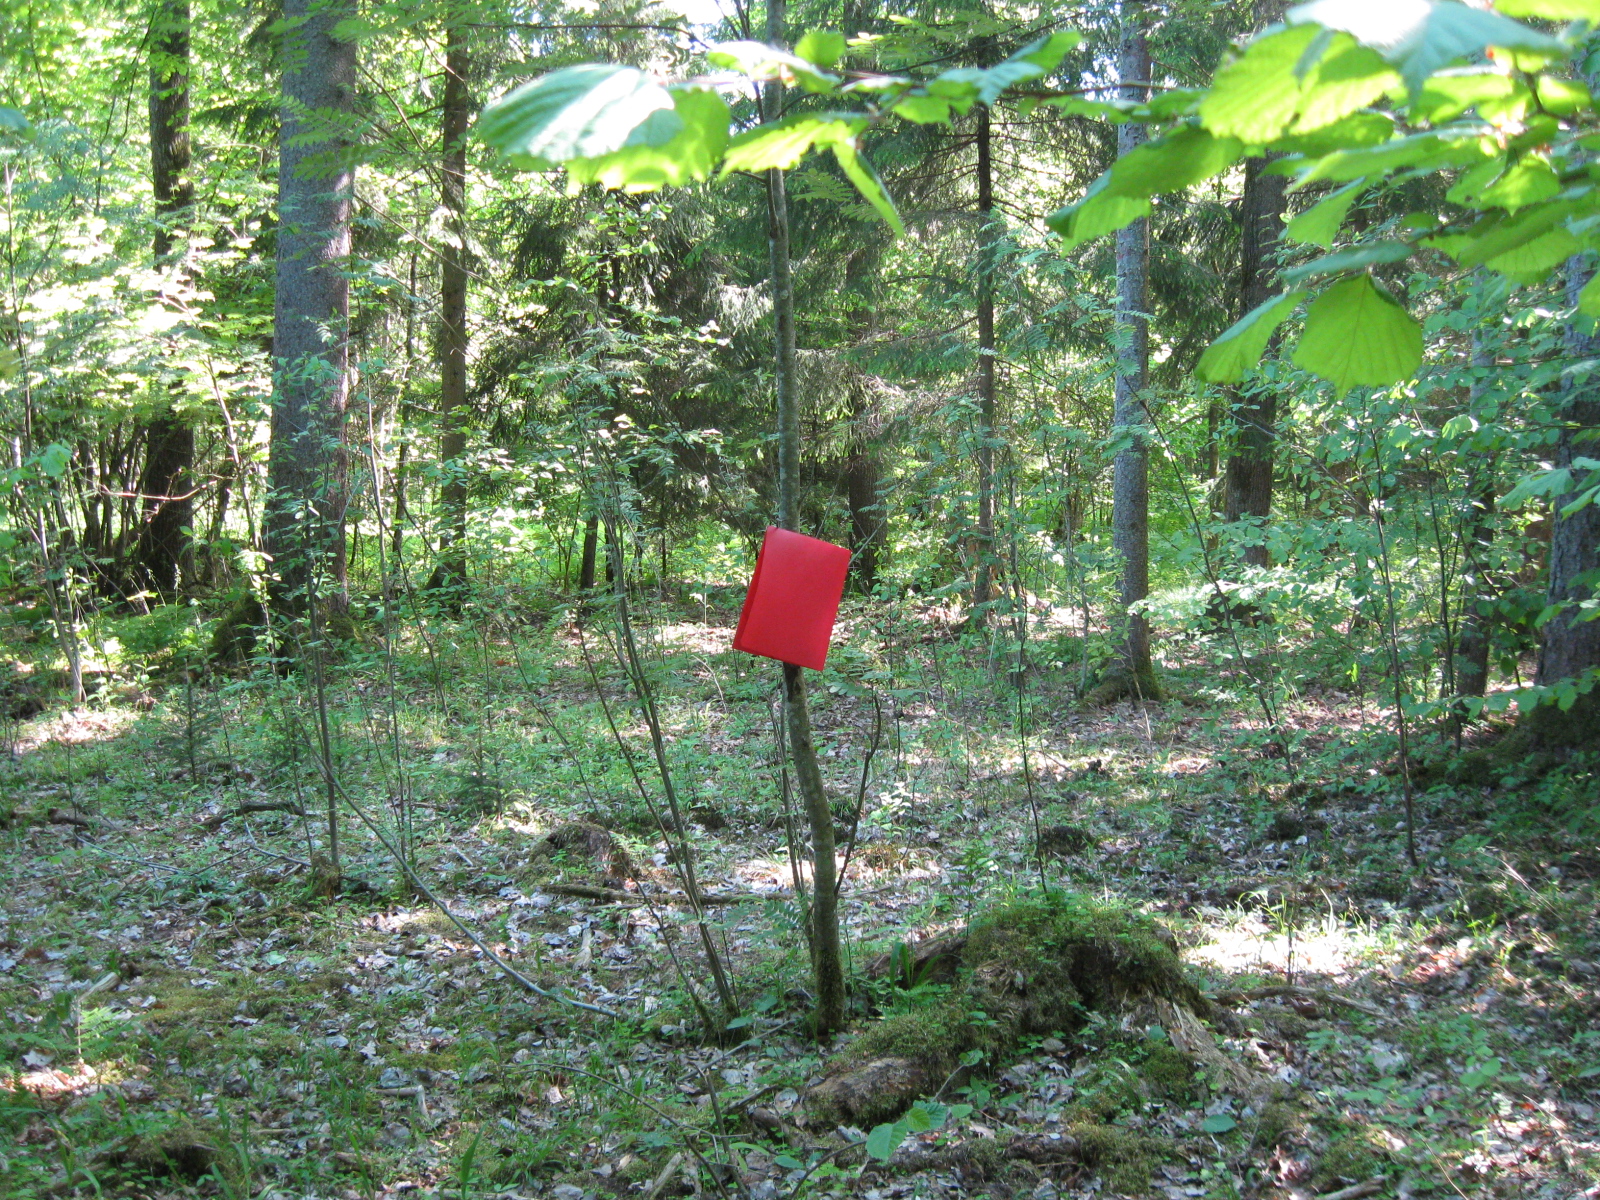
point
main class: Woodland
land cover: Spruce dominated mixed woodland
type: hemiboreal forest and nemoral coniferous forest and mixed broadleaved-coniferous forest
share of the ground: > 75 %
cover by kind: broadleaved forest trees 55 %, coniferous forest trees 40 %, herbaceous plants 5 %
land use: Forestry
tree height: > 5 m
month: June
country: LT
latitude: 54.5565
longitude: 23.8349
